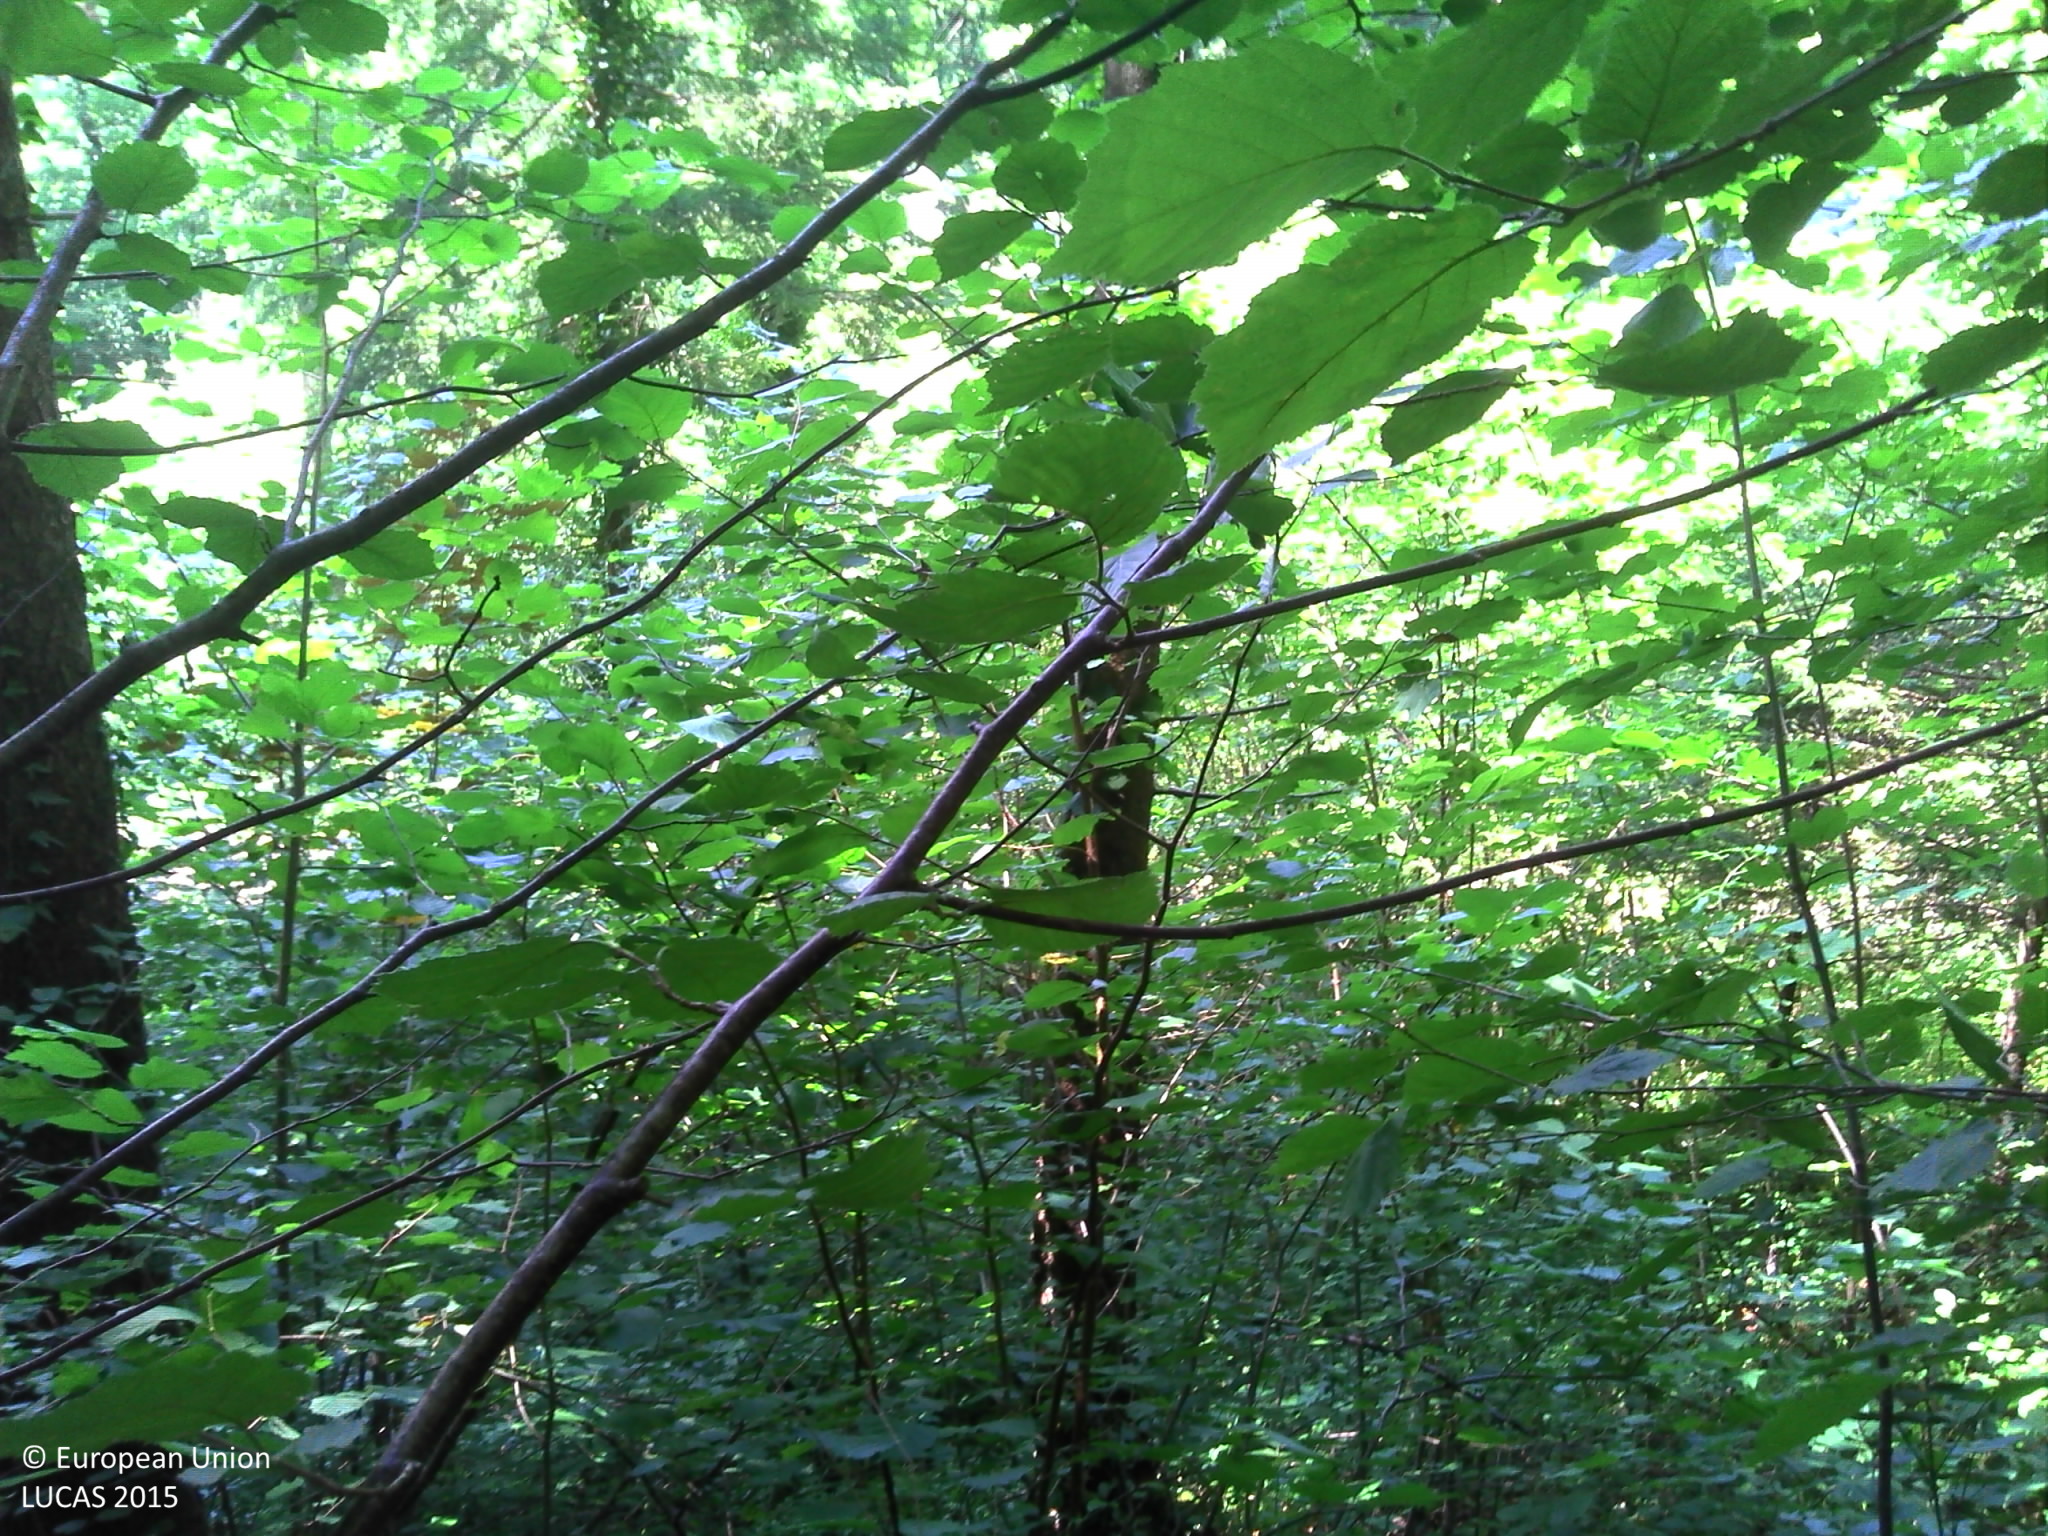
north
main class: Woodland
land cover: Spruce dominated mixed woodland
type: mountainous beech forest
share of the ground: > 75 %
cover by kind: broadleaved forest trees 40 %, coniferous forest trees 35 %, herbaceous plants 20 %, lichens and mosses 5 %
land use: Forestry
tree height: > 5 m
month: July
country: FR
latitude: 45.9562
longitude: 6.1203
